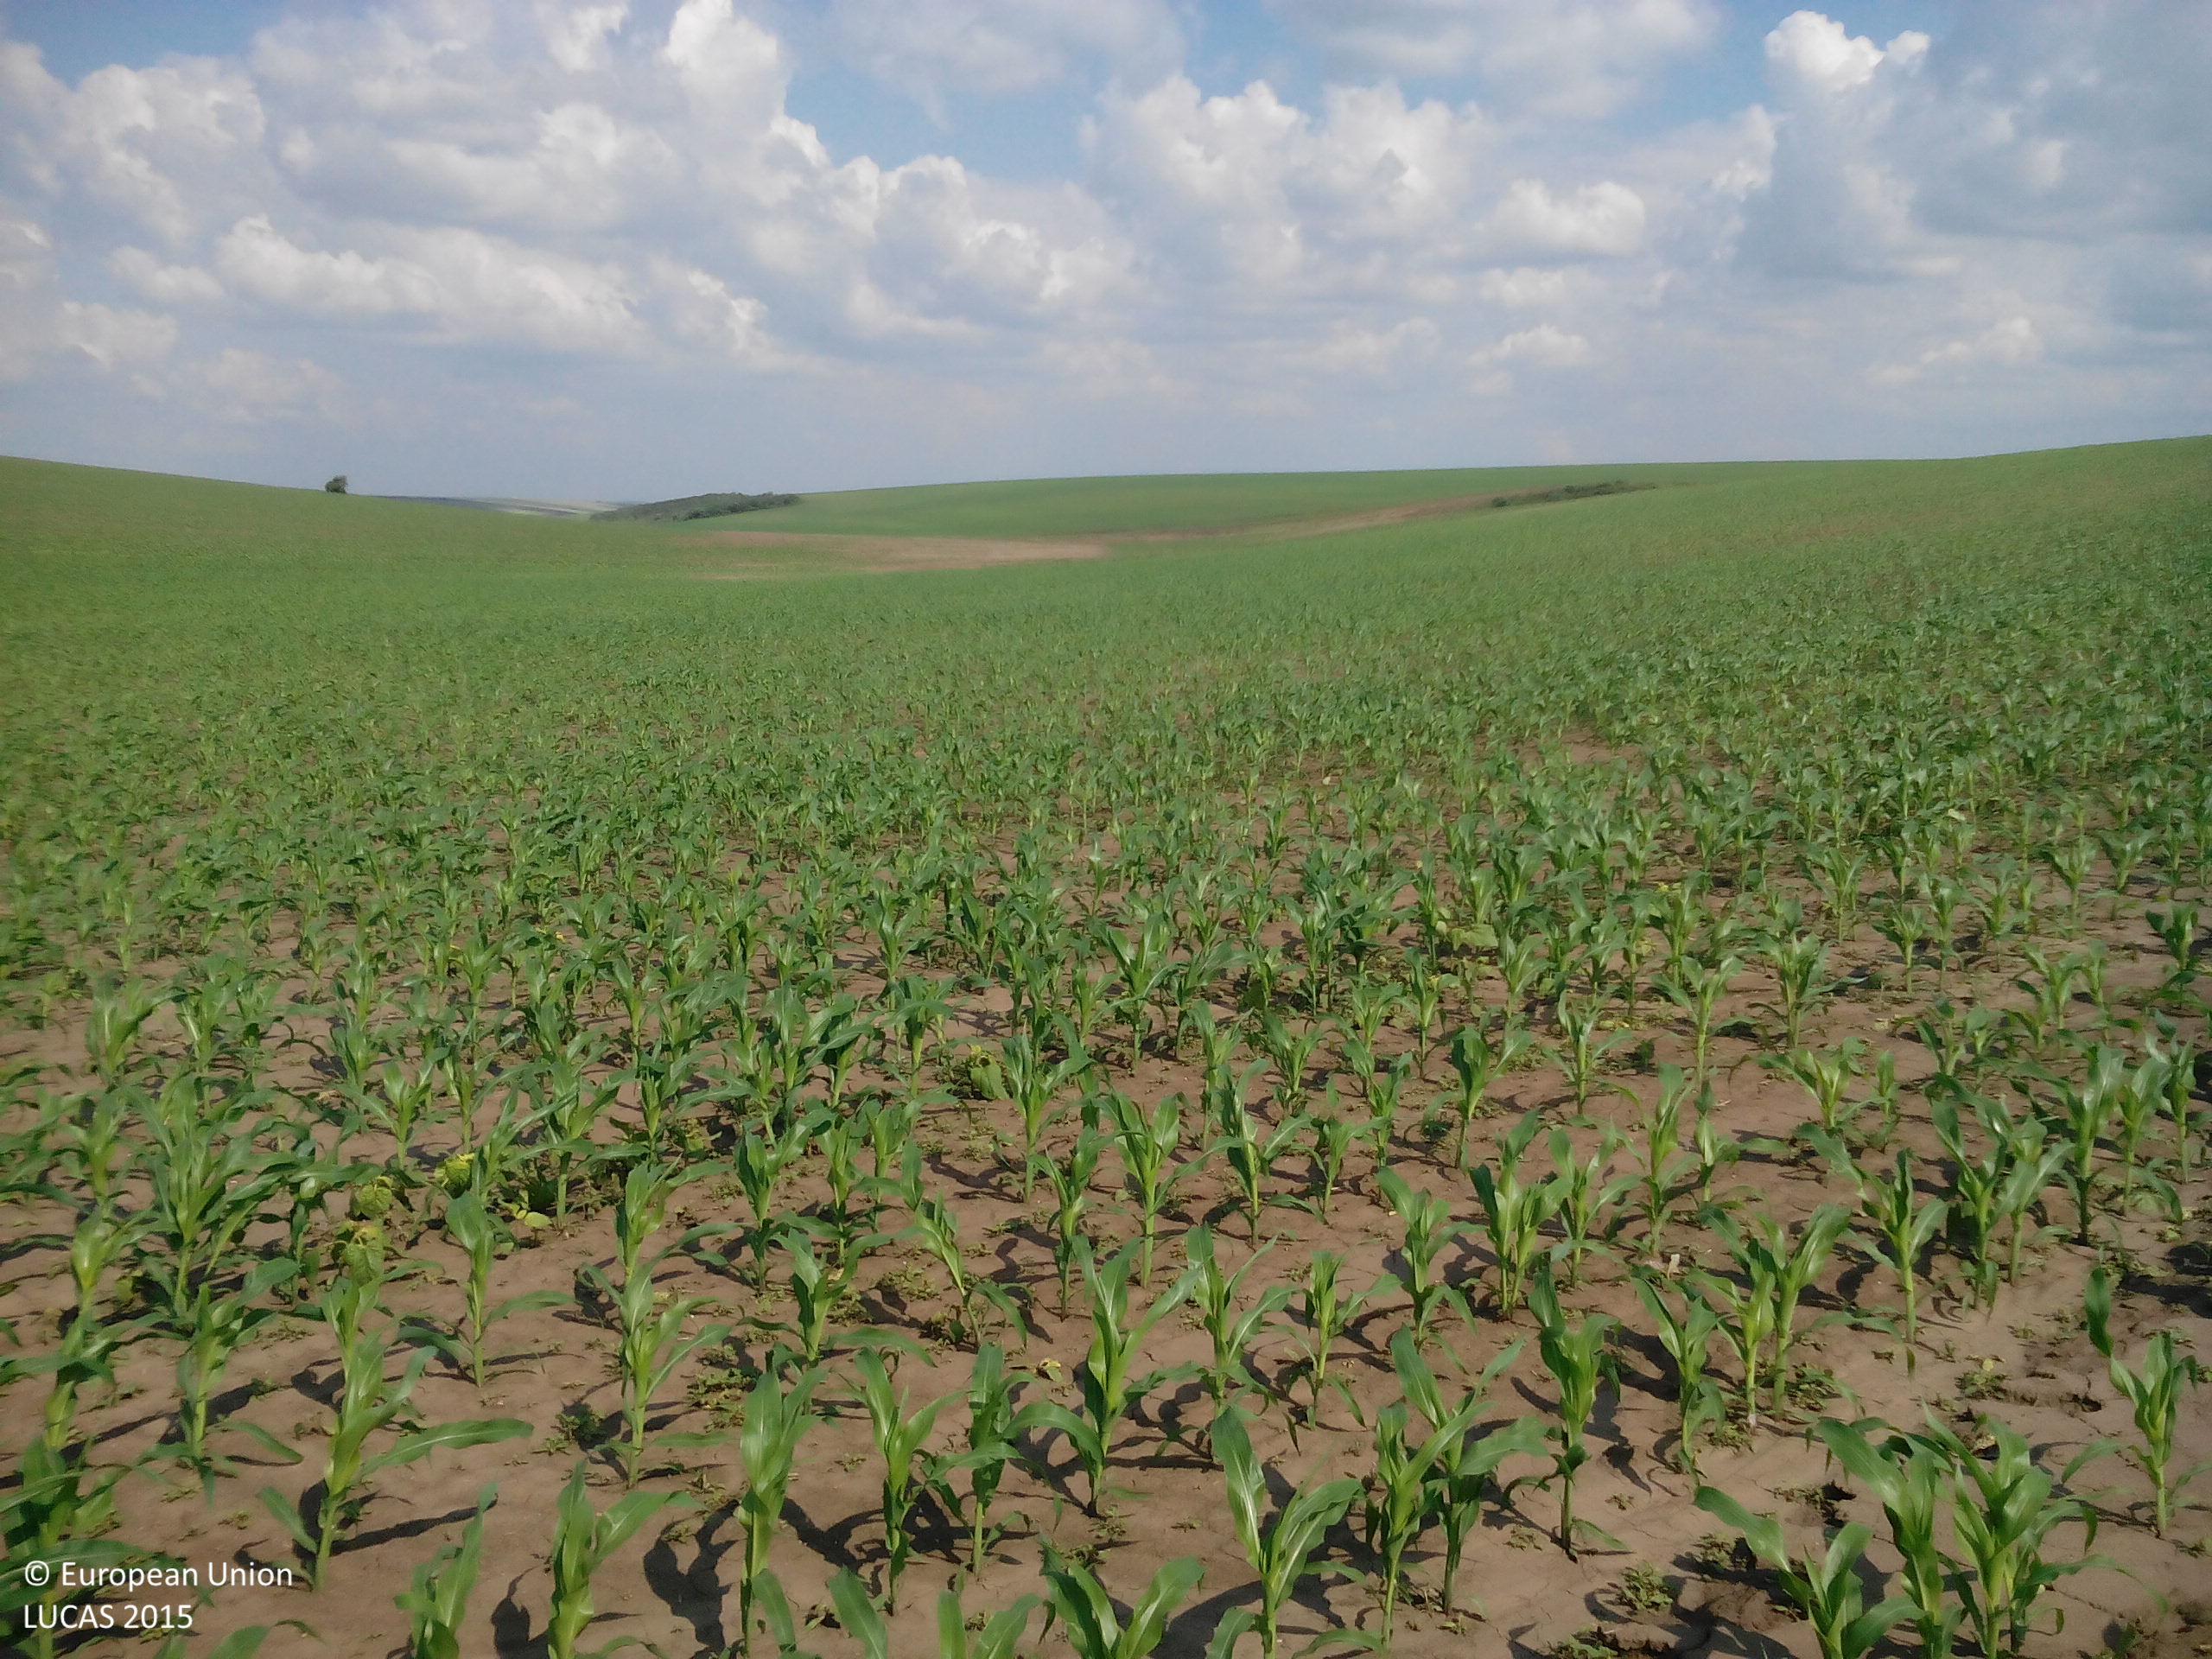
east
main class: Cropland
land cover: Maize
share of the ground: 25 - 50 %
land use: Agriculture (excluding fallow land and kitchen gardens)
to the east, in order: Maize; Sunflower
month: May
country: BG
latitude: 43.5927
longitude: 24.1647
